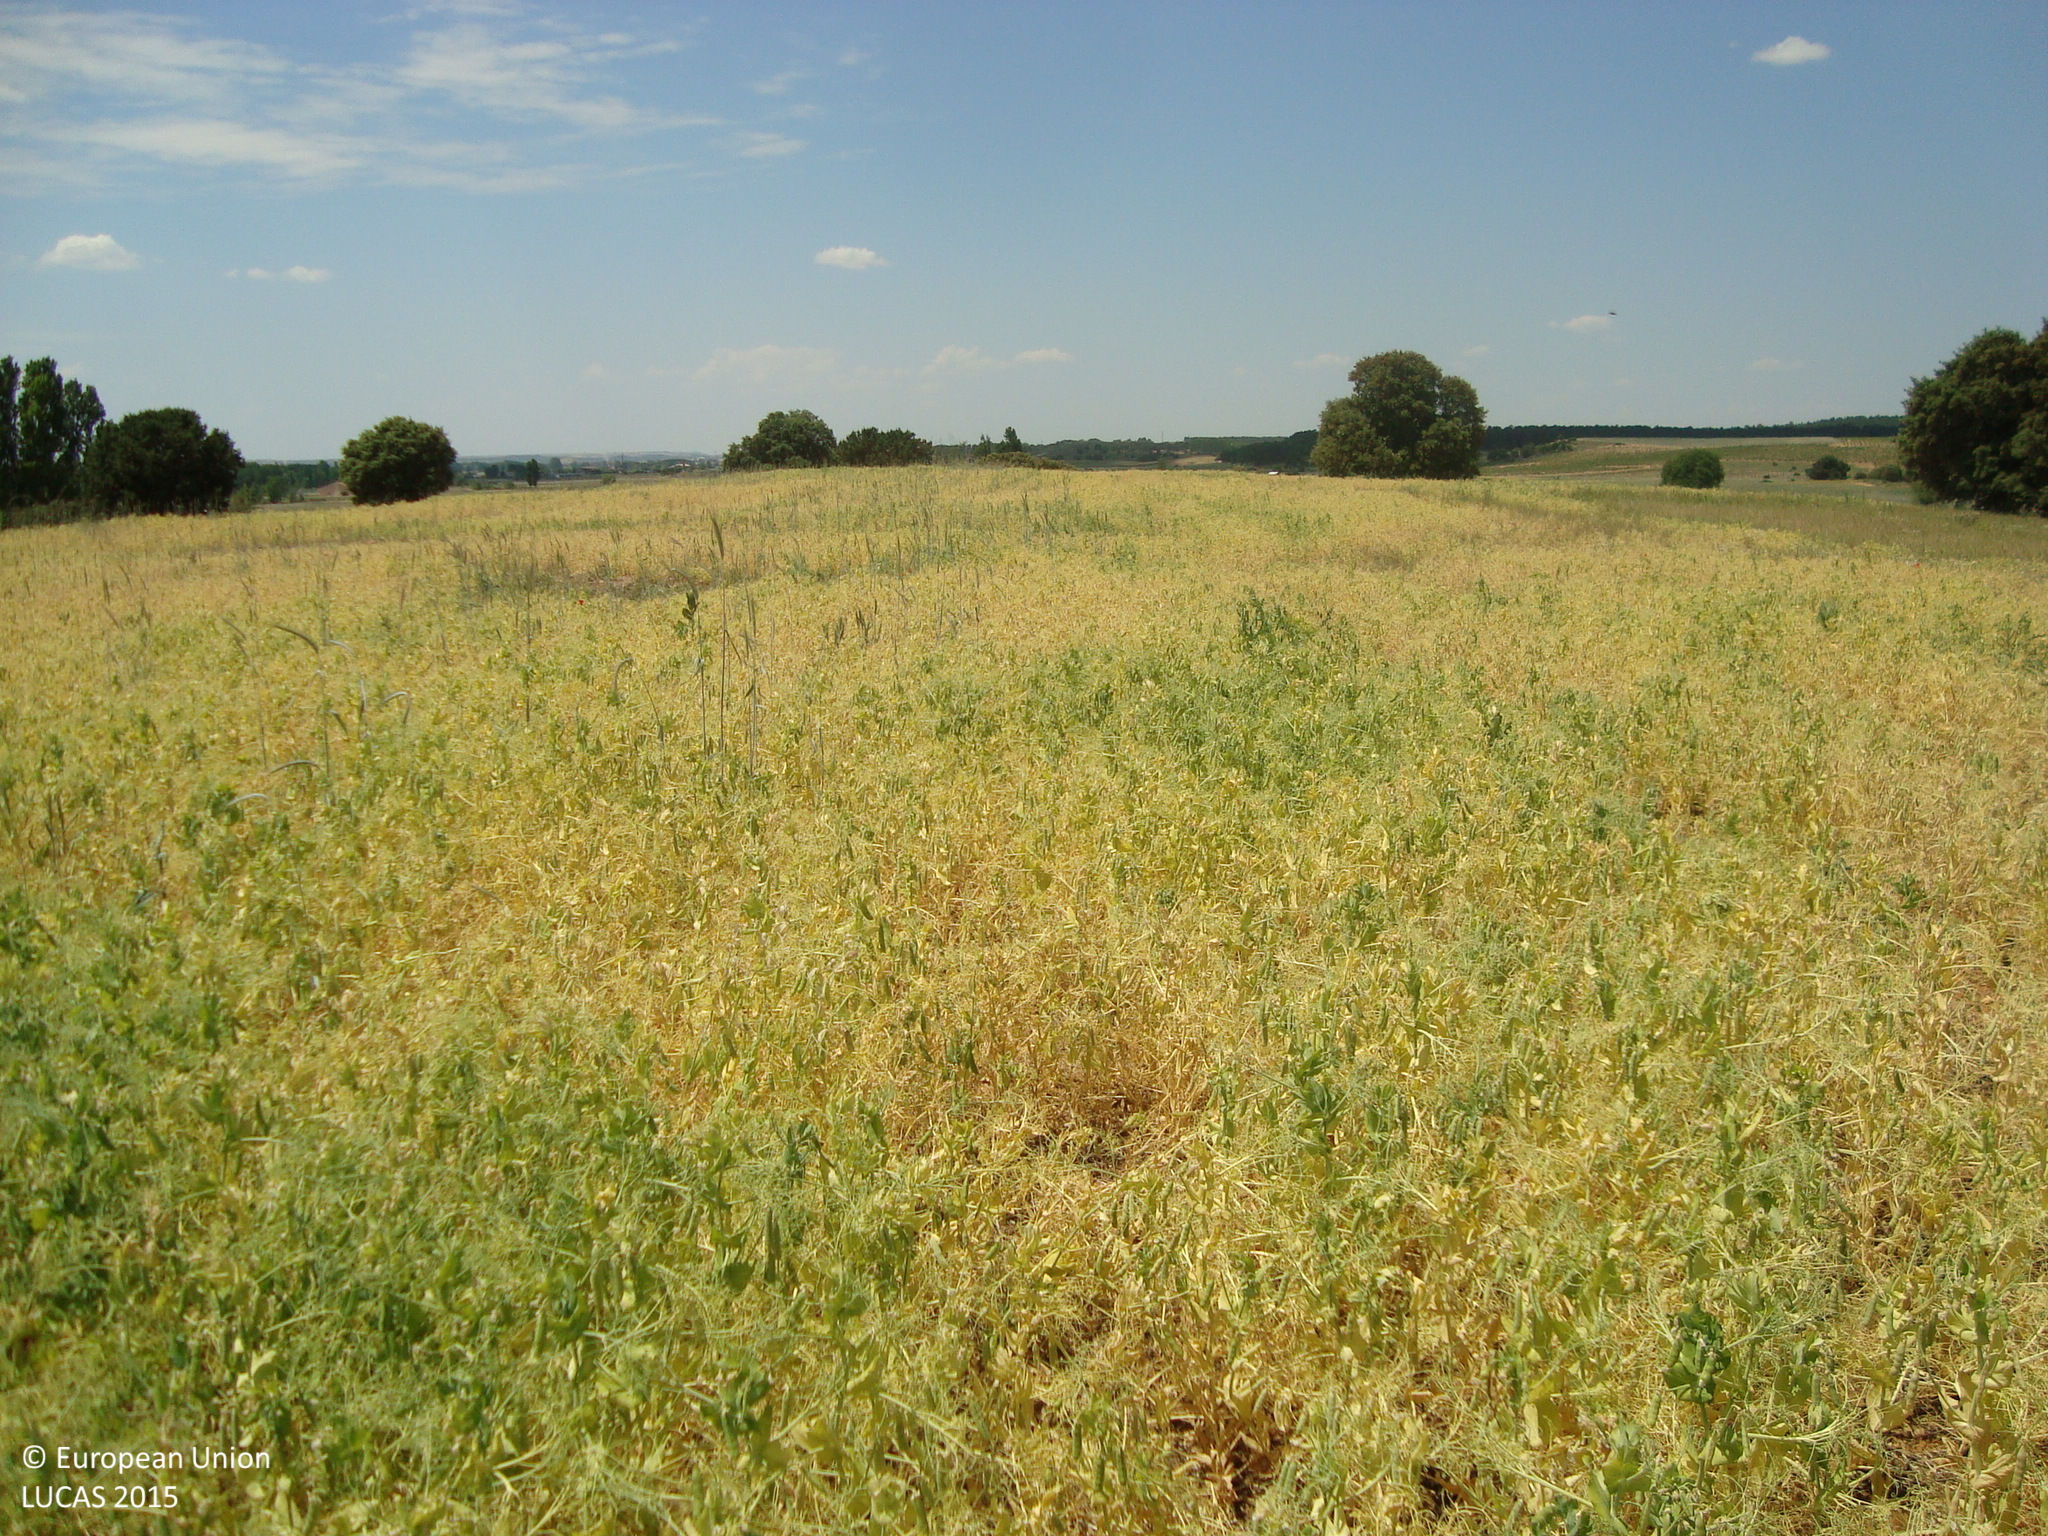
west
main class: Cropland
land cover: Dry pulses
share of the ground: > 75 %
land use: Agriculture (excluding fallow land and kitchen gardens)
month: June
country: ES
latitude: 41.6962
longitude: -3.5935
